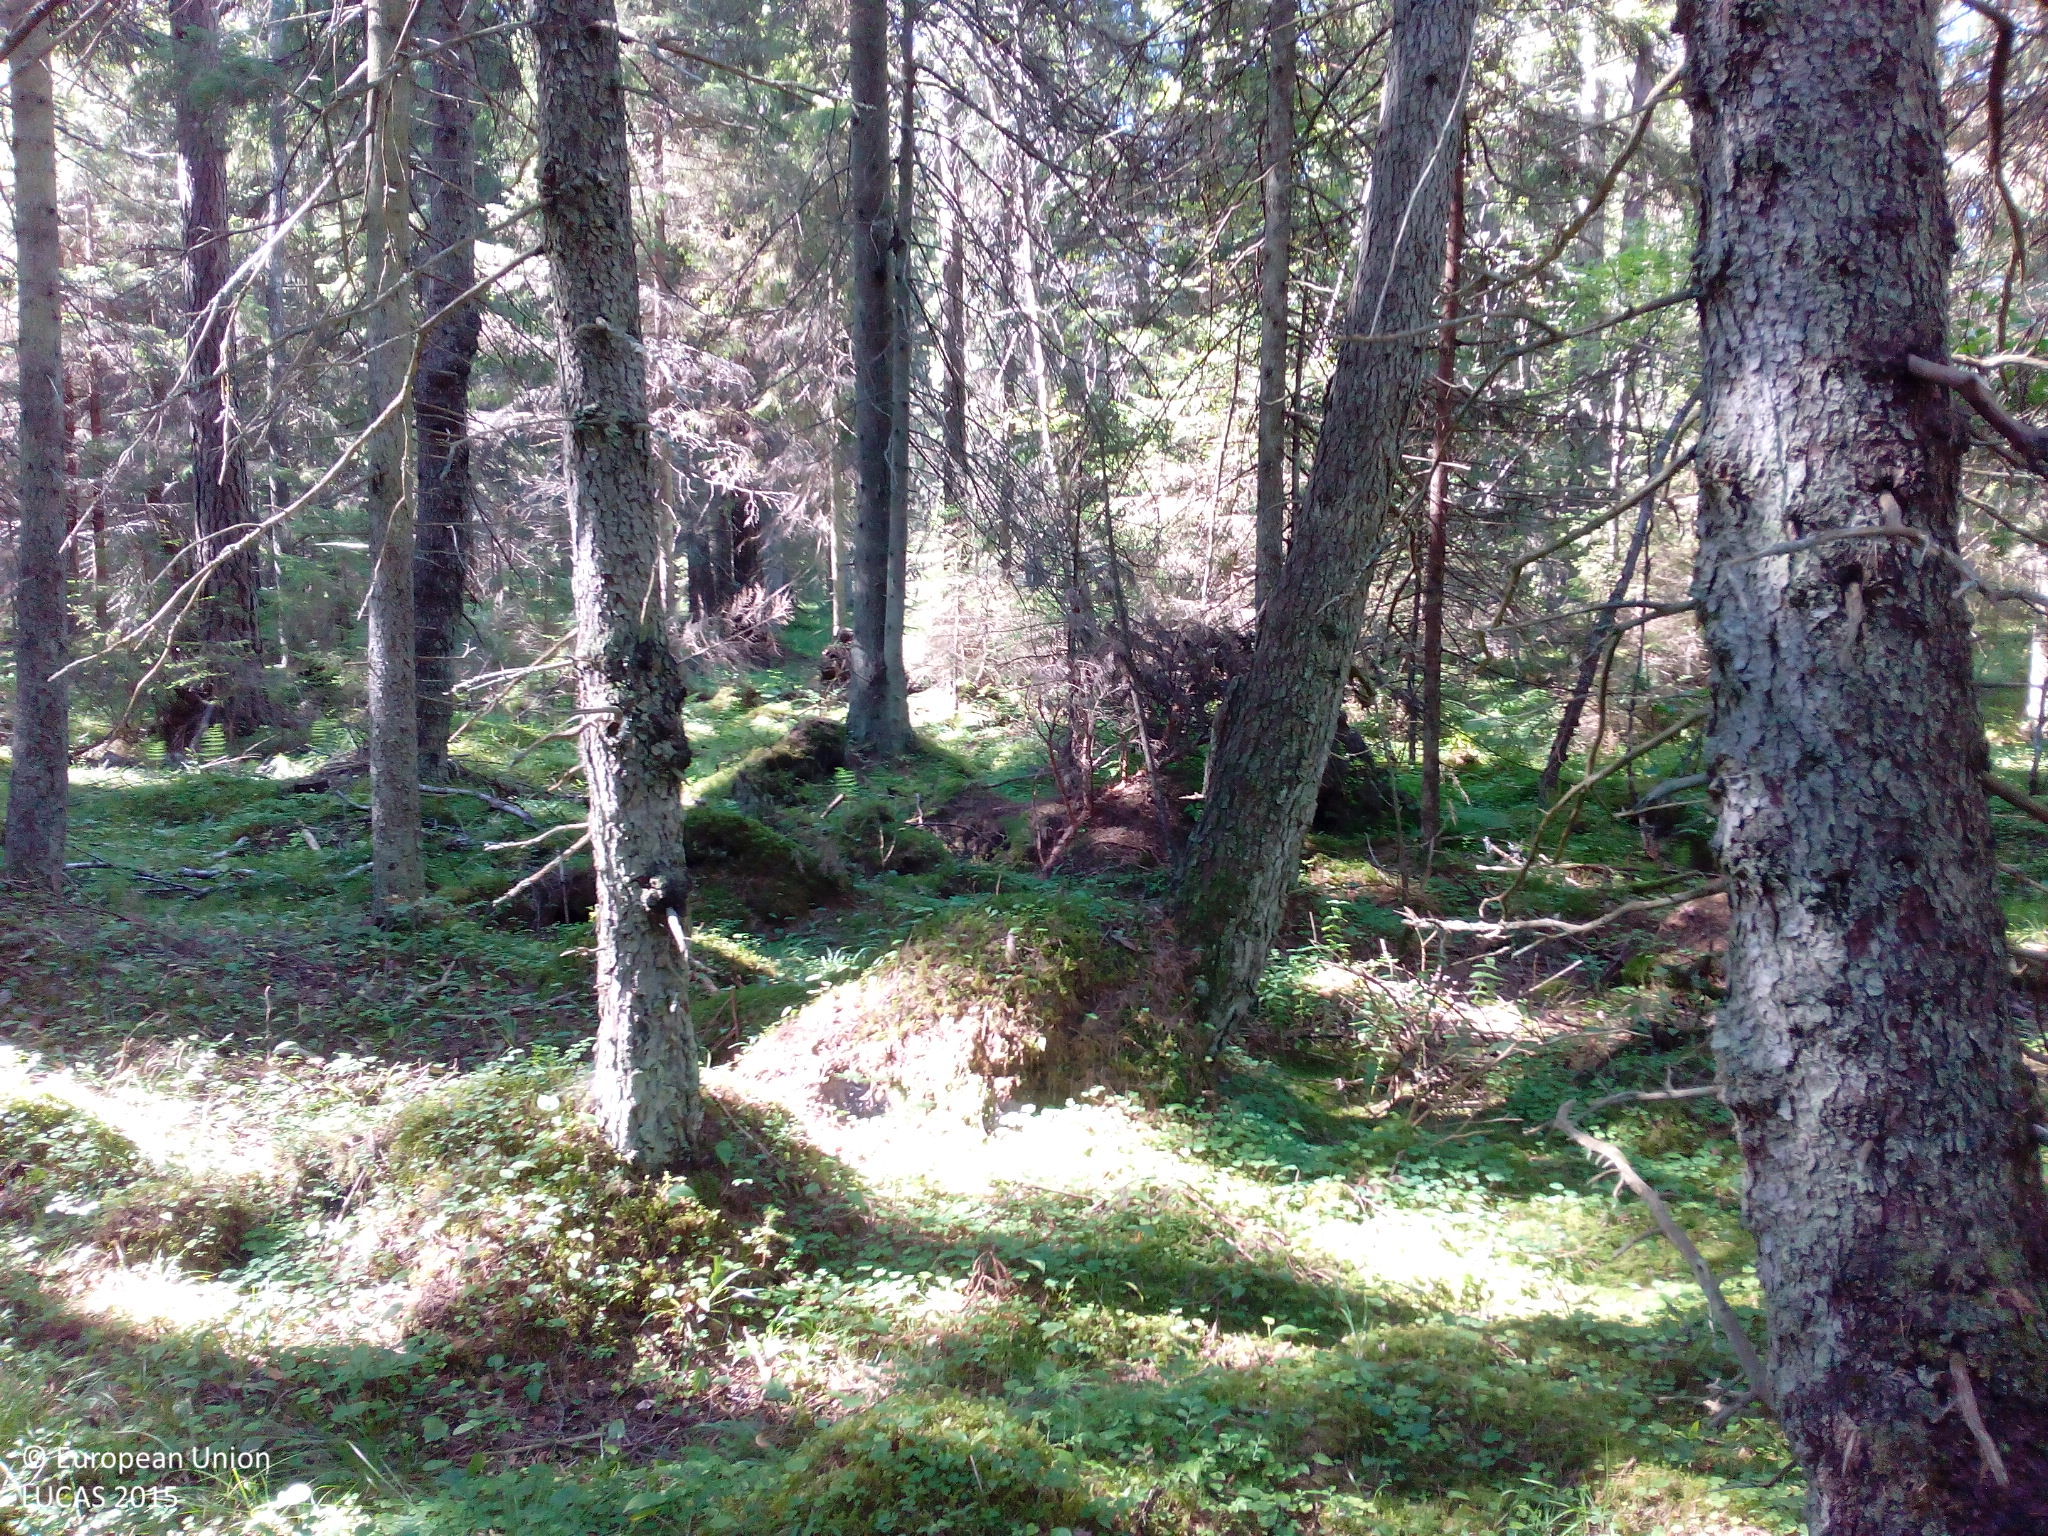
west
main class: Woodland
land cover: Spruce dominated coniferous woodland
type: hemiboreal forest and nemoral coniferous forest and mixed broadleaved-coniferous forest
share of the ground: > 75 %
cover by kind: coniferous forest trees 90 %, herbaceous plants 5 %, lichens and mosses 5 %
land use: Forestry
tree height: > 5 m
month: August
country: FI
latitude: 60.1410
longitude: 19.8921
